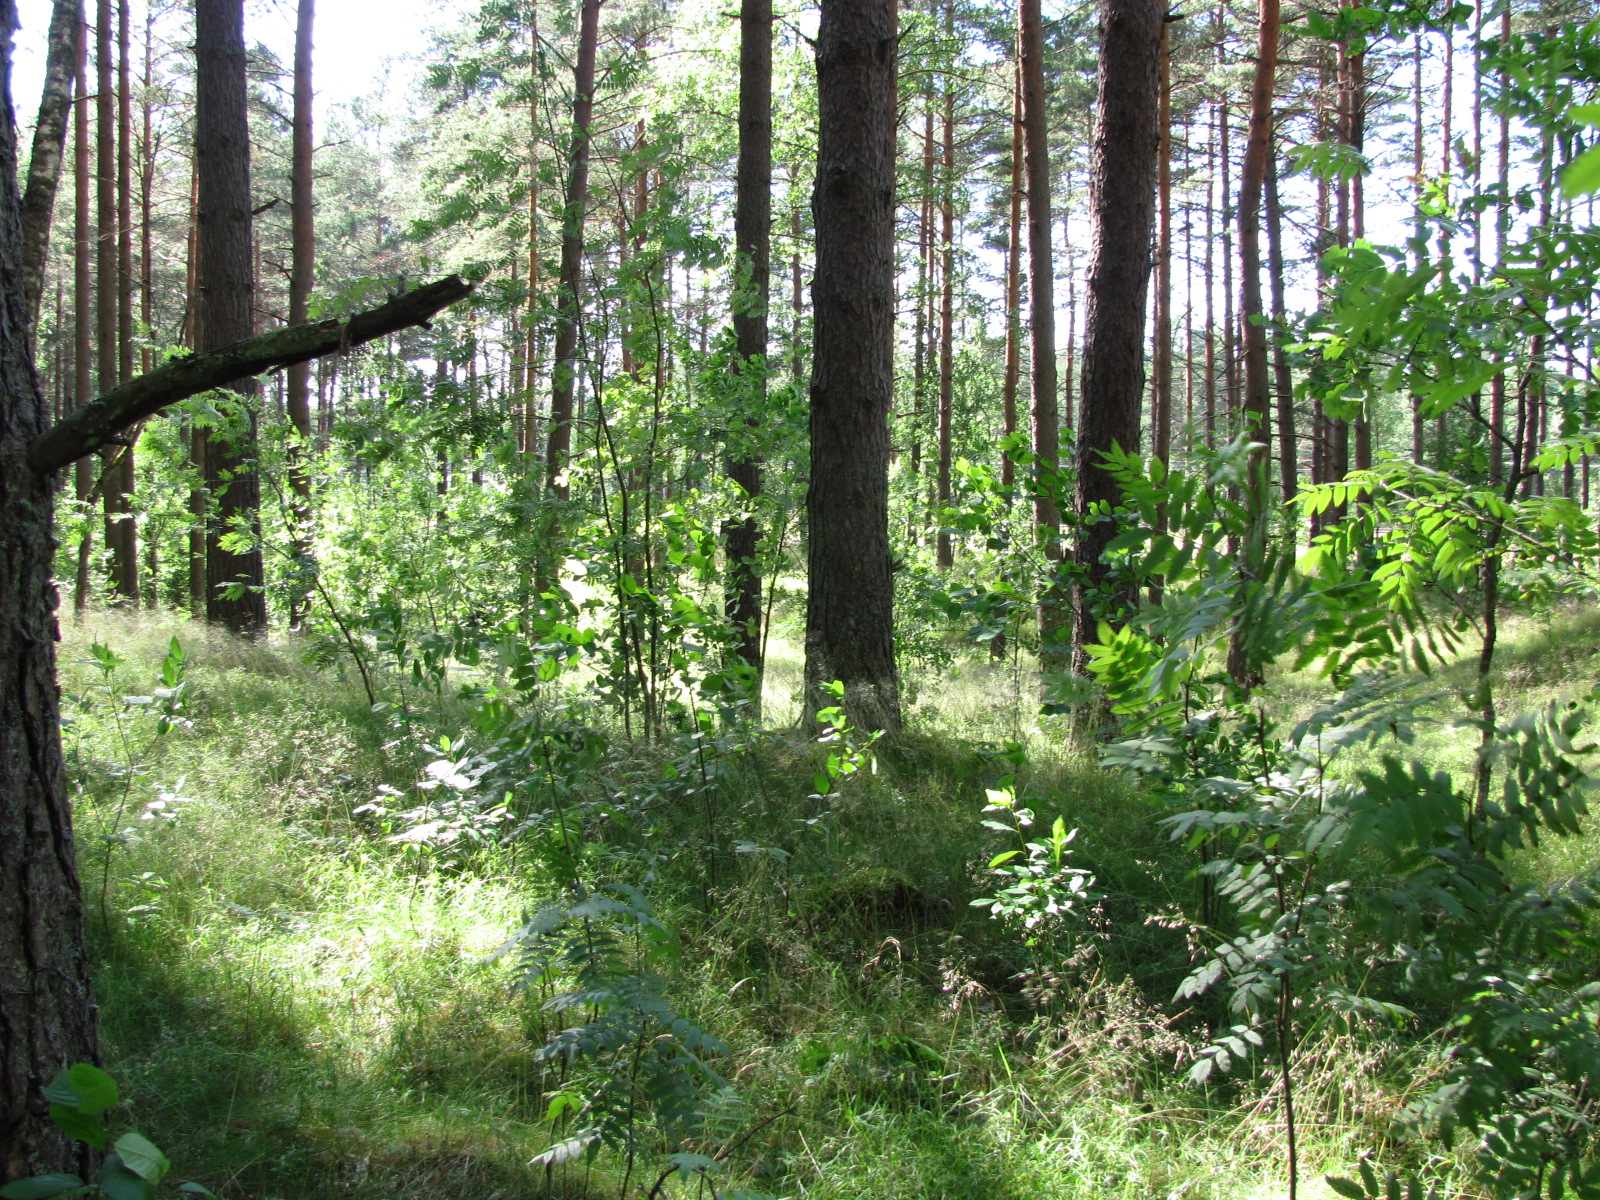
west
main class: Woodland
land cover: Pine dominated mixed woodland
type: hemiboreal forest and nemoral coniferous forest and mixed broadleaved-coniferous forest
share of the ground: > 75 %
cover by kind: coniferous forest trees 55 %, broadleaved forest trees 25 %, herbaceous plants 15 %, shrubs 5 %
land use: Forestry
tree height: > 5 m
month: July
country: LV
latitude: 57.0097
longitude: 24.3002
